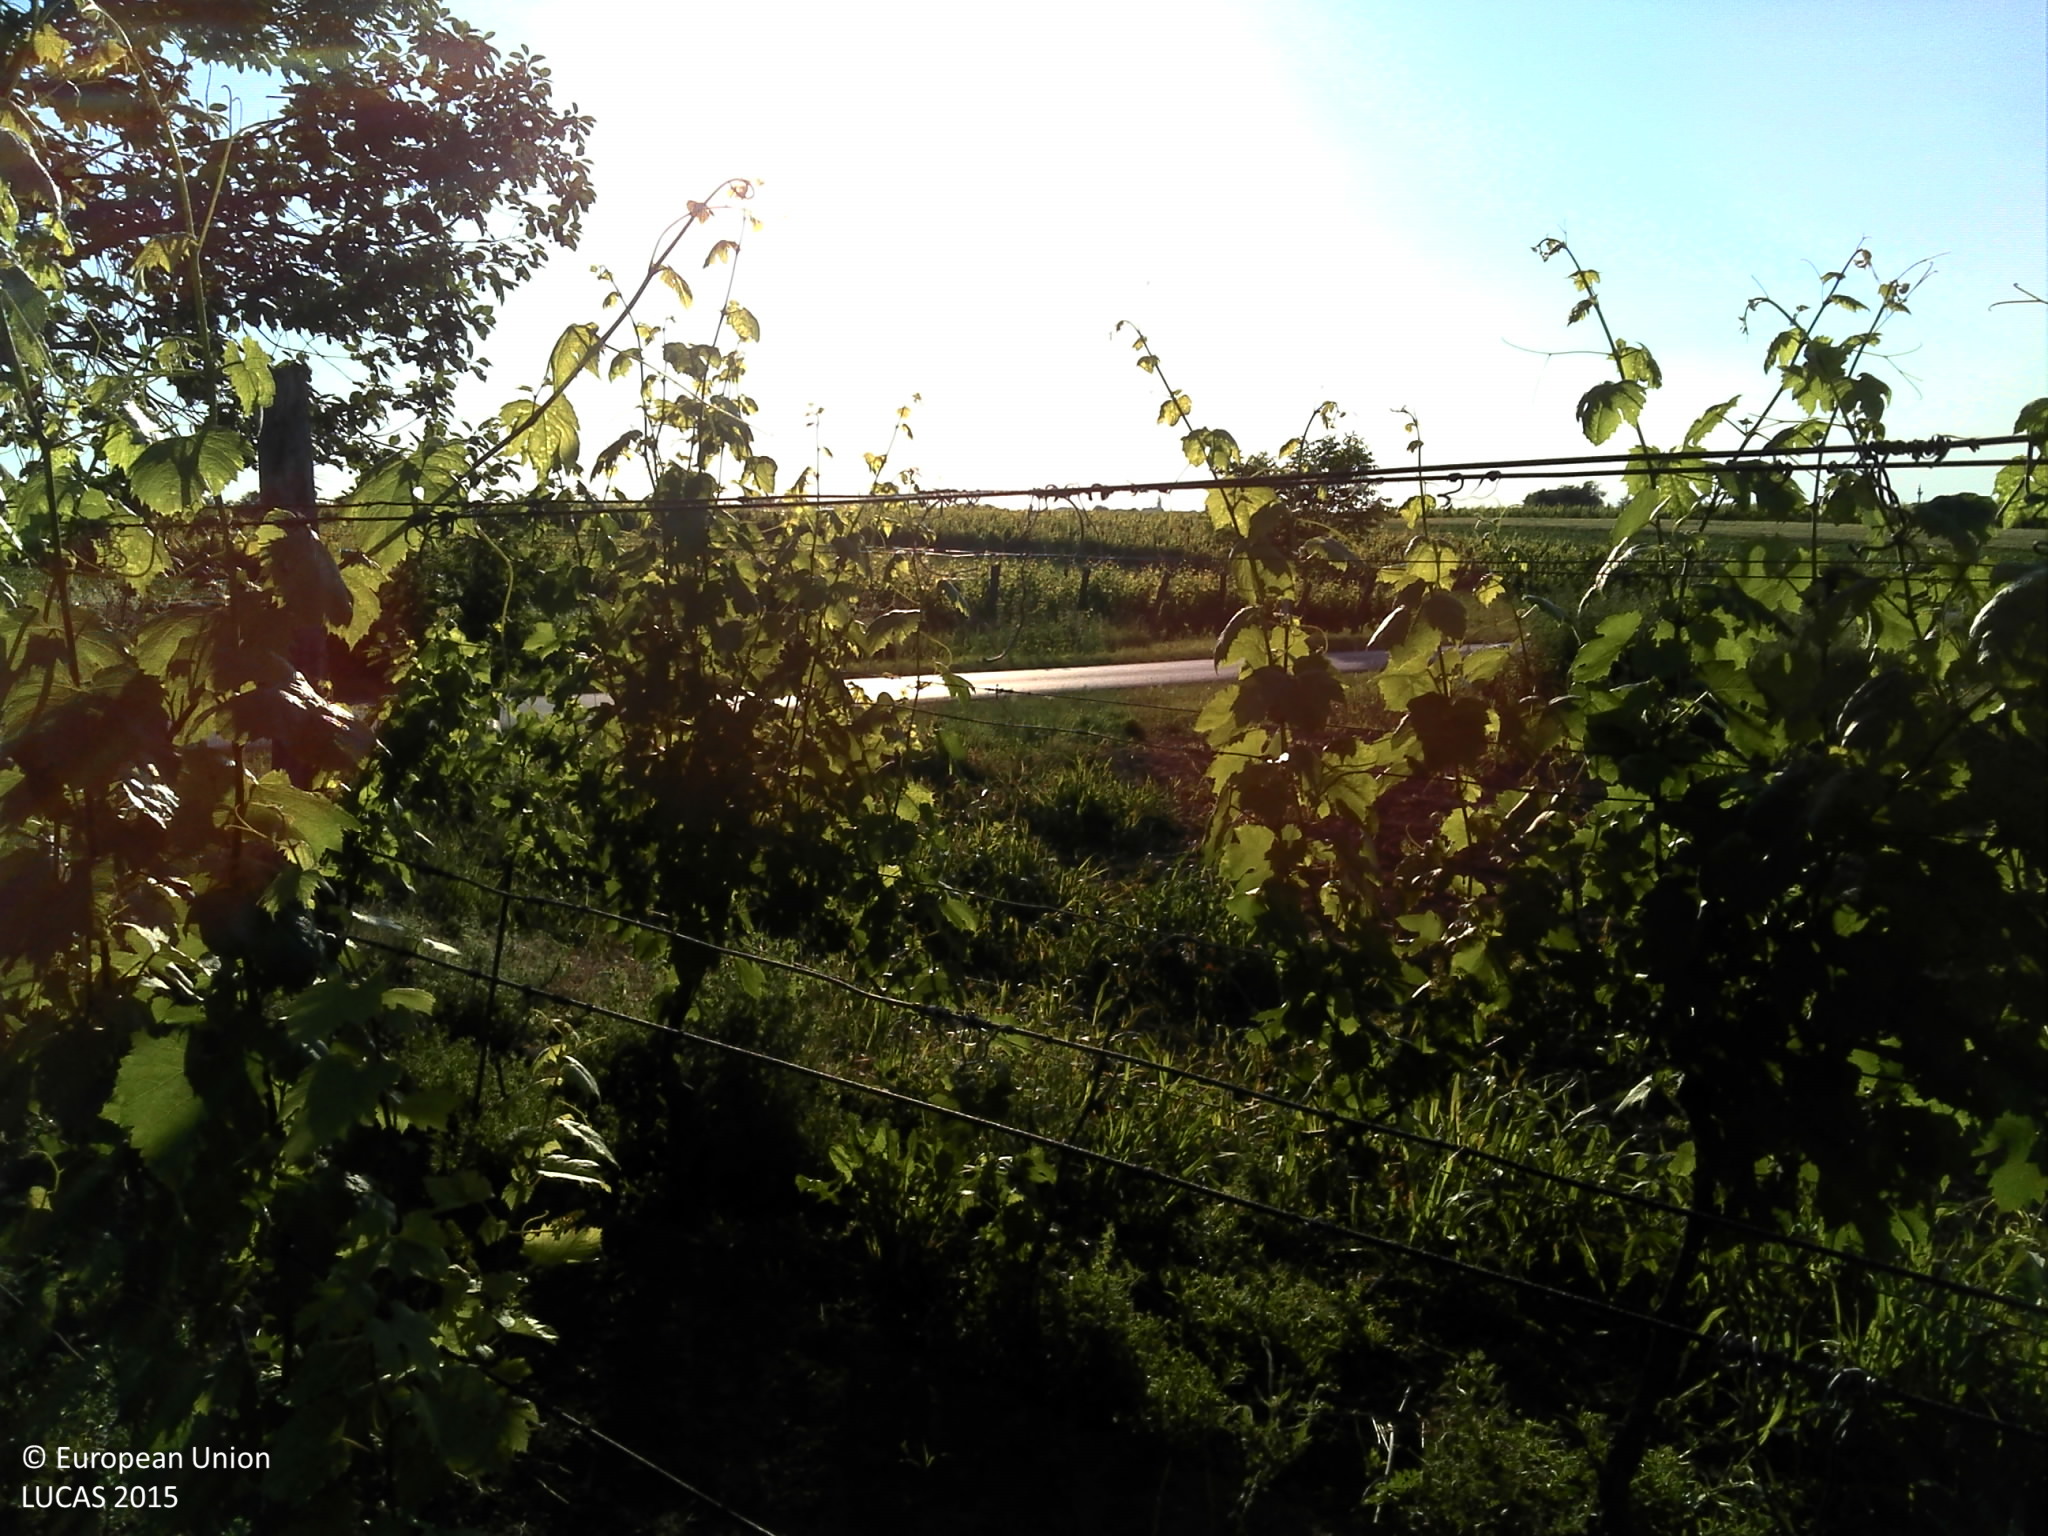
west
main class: Cropland
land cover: Vineyards
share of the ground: 10 - 25 %
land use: Agriculture (excluding fallow land and kitchen gardens)
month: June
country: HR
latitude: 45.2093
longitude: 19.4201
